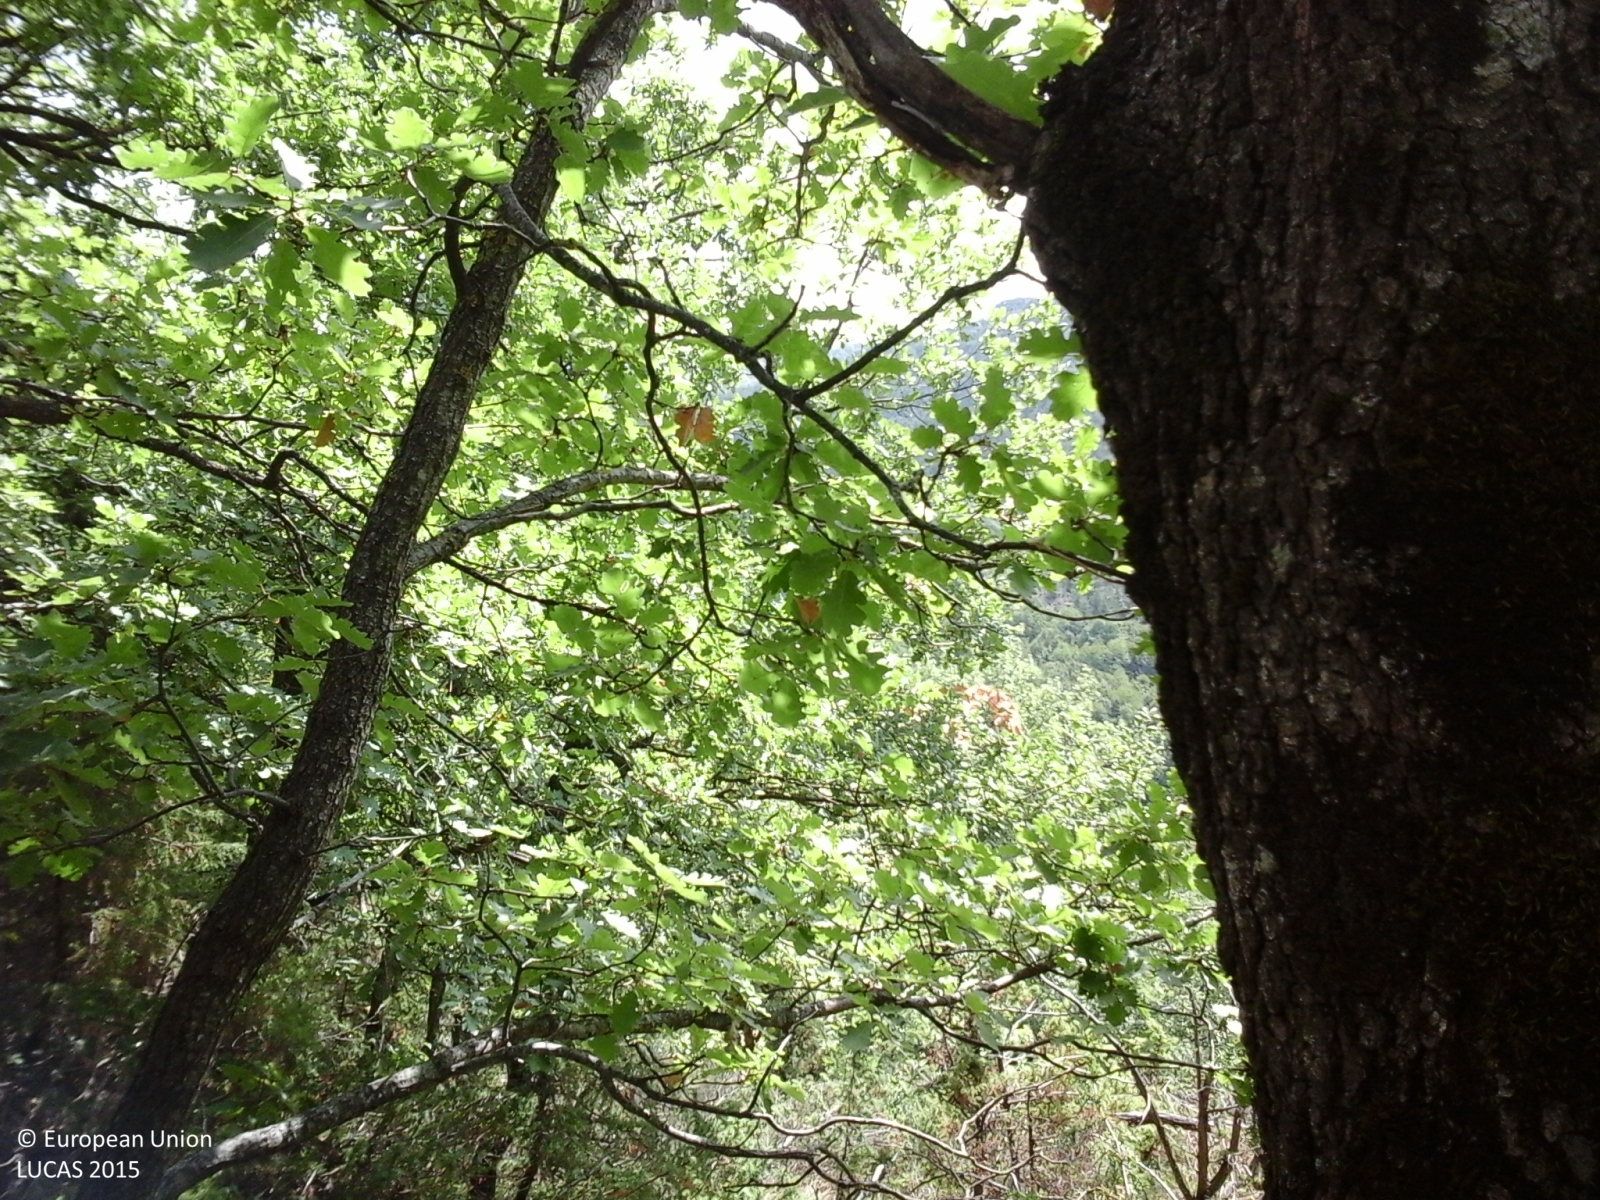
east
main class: Woodland
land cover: Broadleaved woodland
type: thermophilous deciduous forest
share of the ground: > 75 %
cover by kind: broadleaved forest trees 100 %
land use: Forestry
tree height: > 5 m
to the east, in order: Broadleaved woodland; Grass margins; Paved roads, cycling and walking lanes; Grass margins; Electric lines; Broadleaved woodland; Grass margins; Paved roads, cycling and walking lanes; Grass margins; Spontaneously vegetated surfaces; Artificial constructions in urban areas
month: August
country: IT
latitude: 42.8875
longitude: 13.3576
